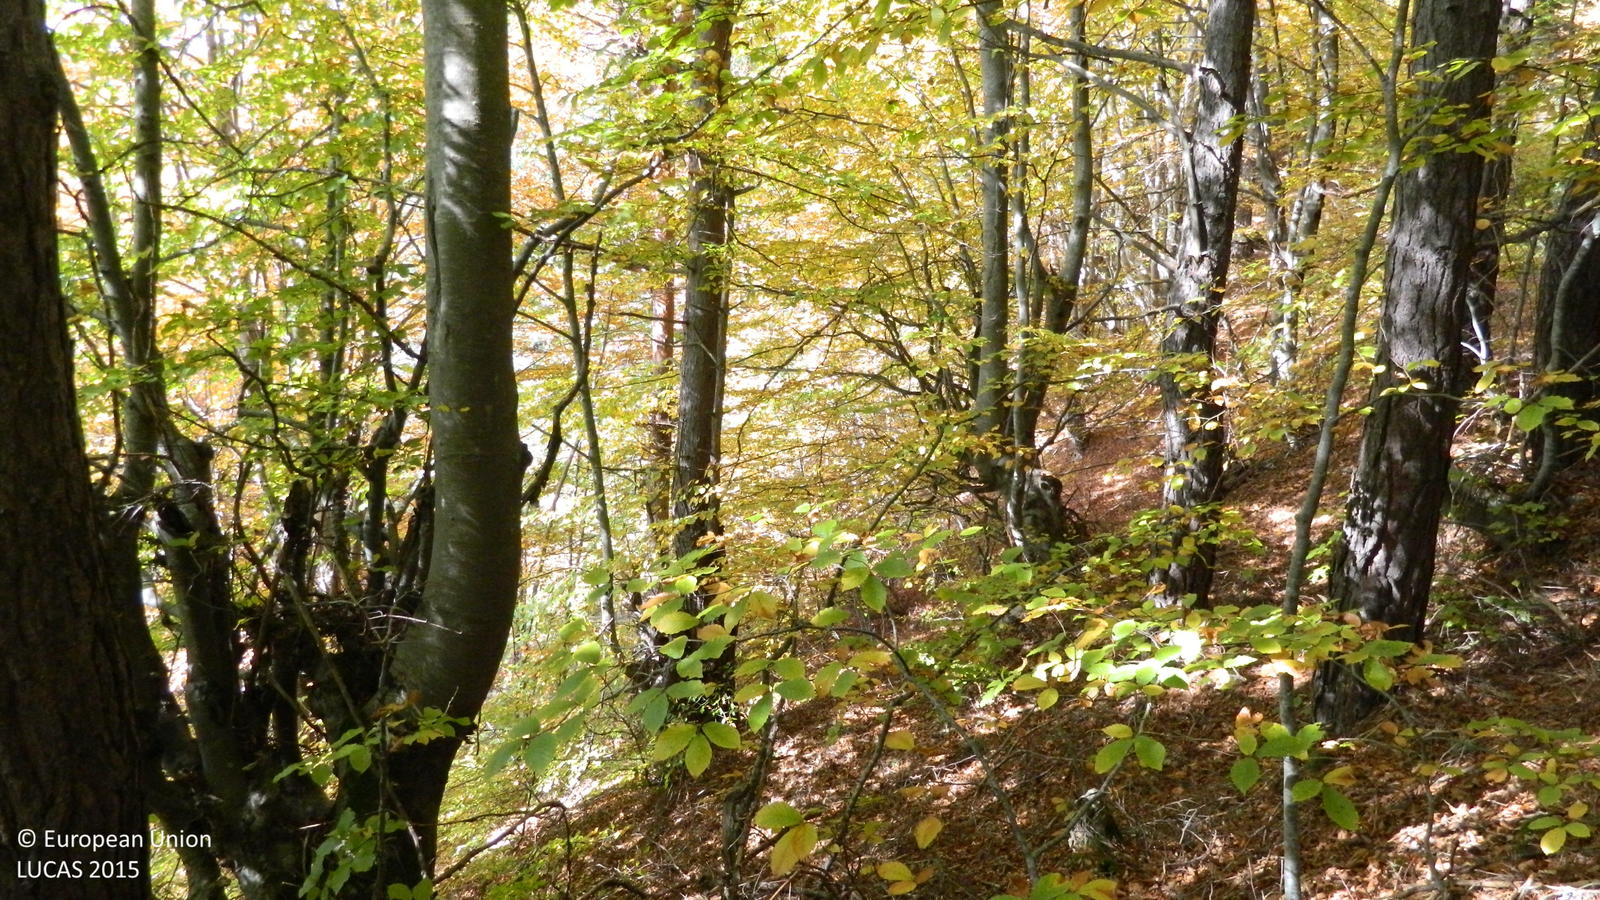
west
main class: Woodland
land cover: Pine dominated mixed woodland
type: hemiboreal forest and nemoral coniferous forest and mixed broadleaved-coniferous forest
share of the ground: > 75 %
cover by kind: coniferous forest trees 65 %, broadleaved forest trees 35 %
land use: Forestry
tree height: > 5 m
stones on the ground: < 10 %
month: October
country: BG
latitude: 41.4986
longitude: 24.5957
